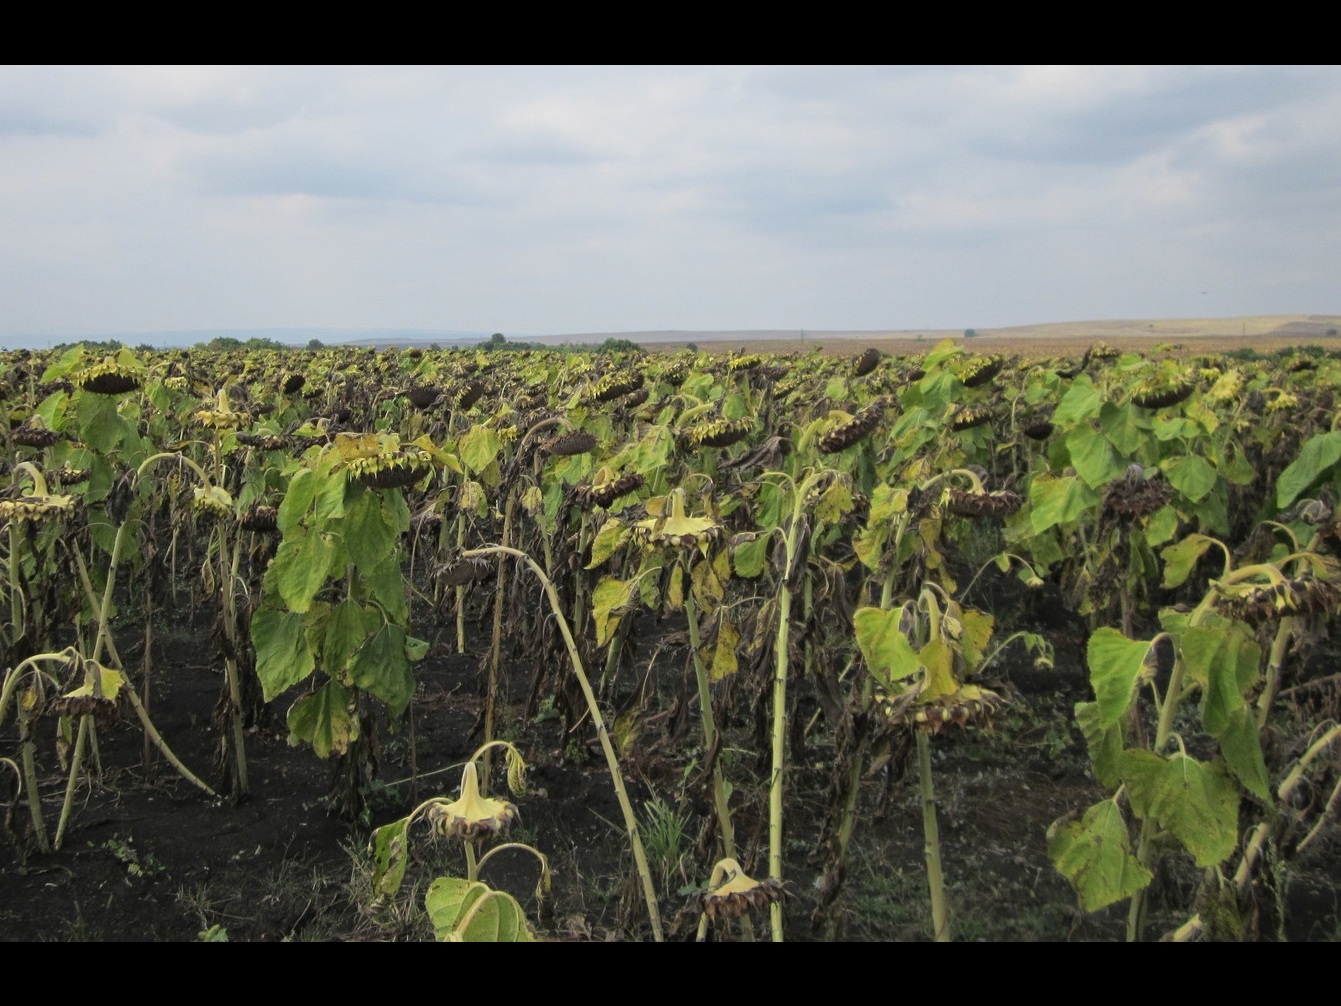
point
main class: Cropland
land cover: Sunflower
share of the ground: > 75 %
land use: Agriculture (excluding fallow land and kitchen gardens)
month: August
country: BG
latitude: 42.5304
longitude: 26.8908
